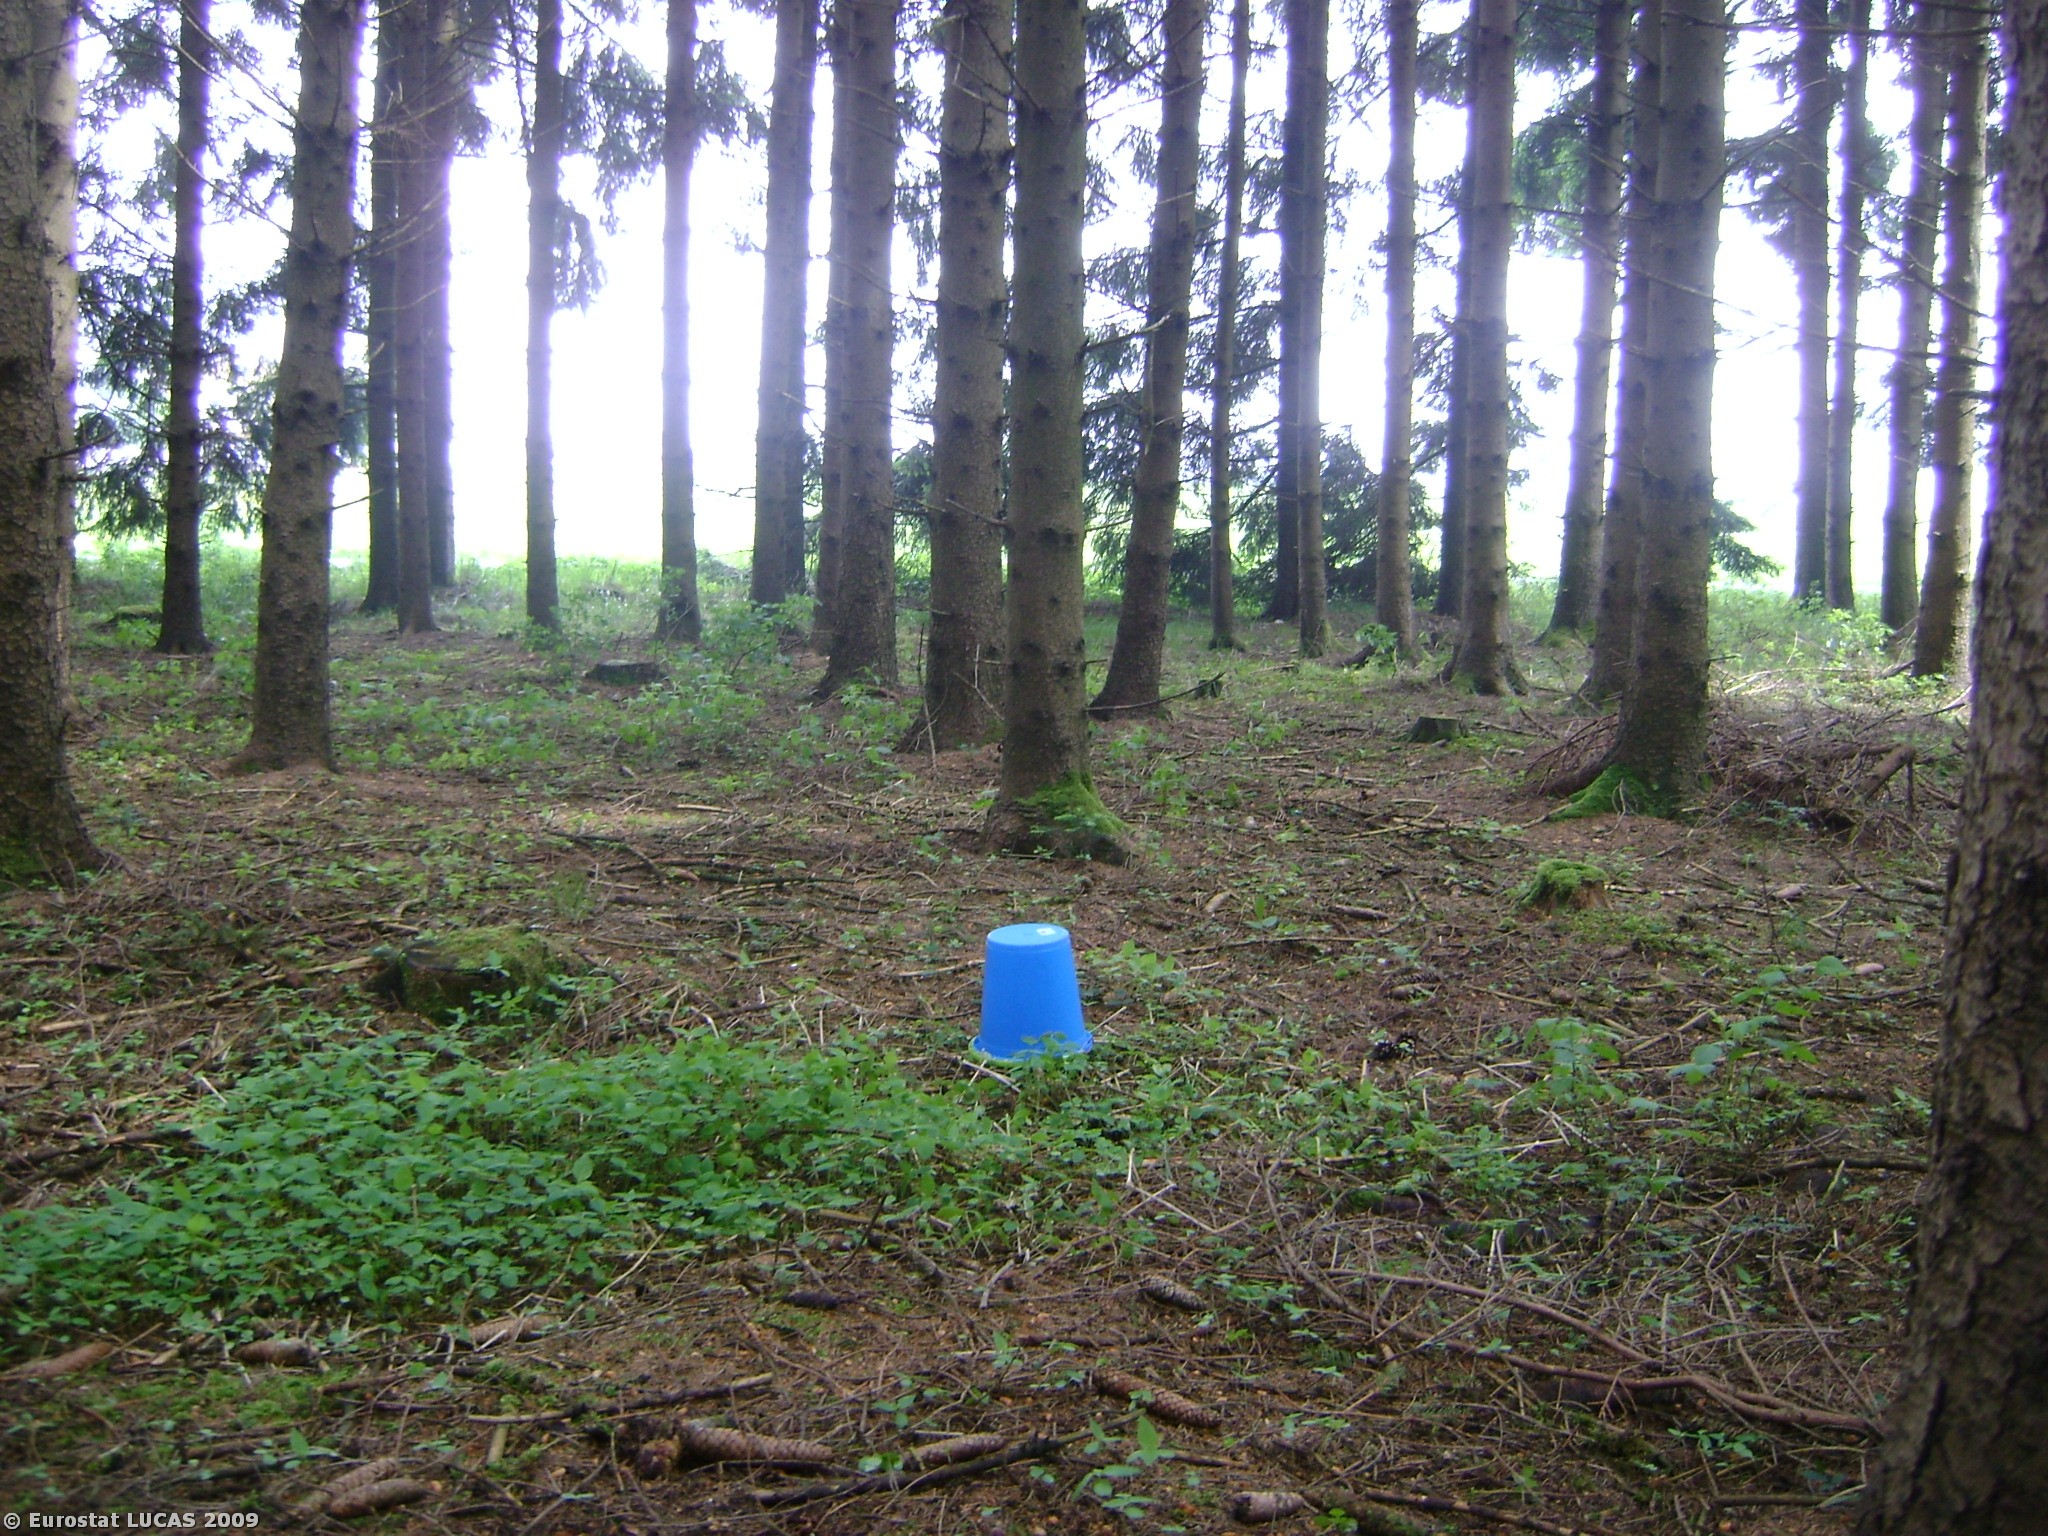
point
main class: Woodland
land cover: Coniferous woodland
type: hemiboreal forest and nemoral coniferous forest and mixed broadleaved-coniferous forest
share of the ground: > 75 %
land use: Forestry
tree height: > 5 m
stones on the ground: < 10 %
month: May
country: AT
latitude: 47.9782
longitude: 13.2275
